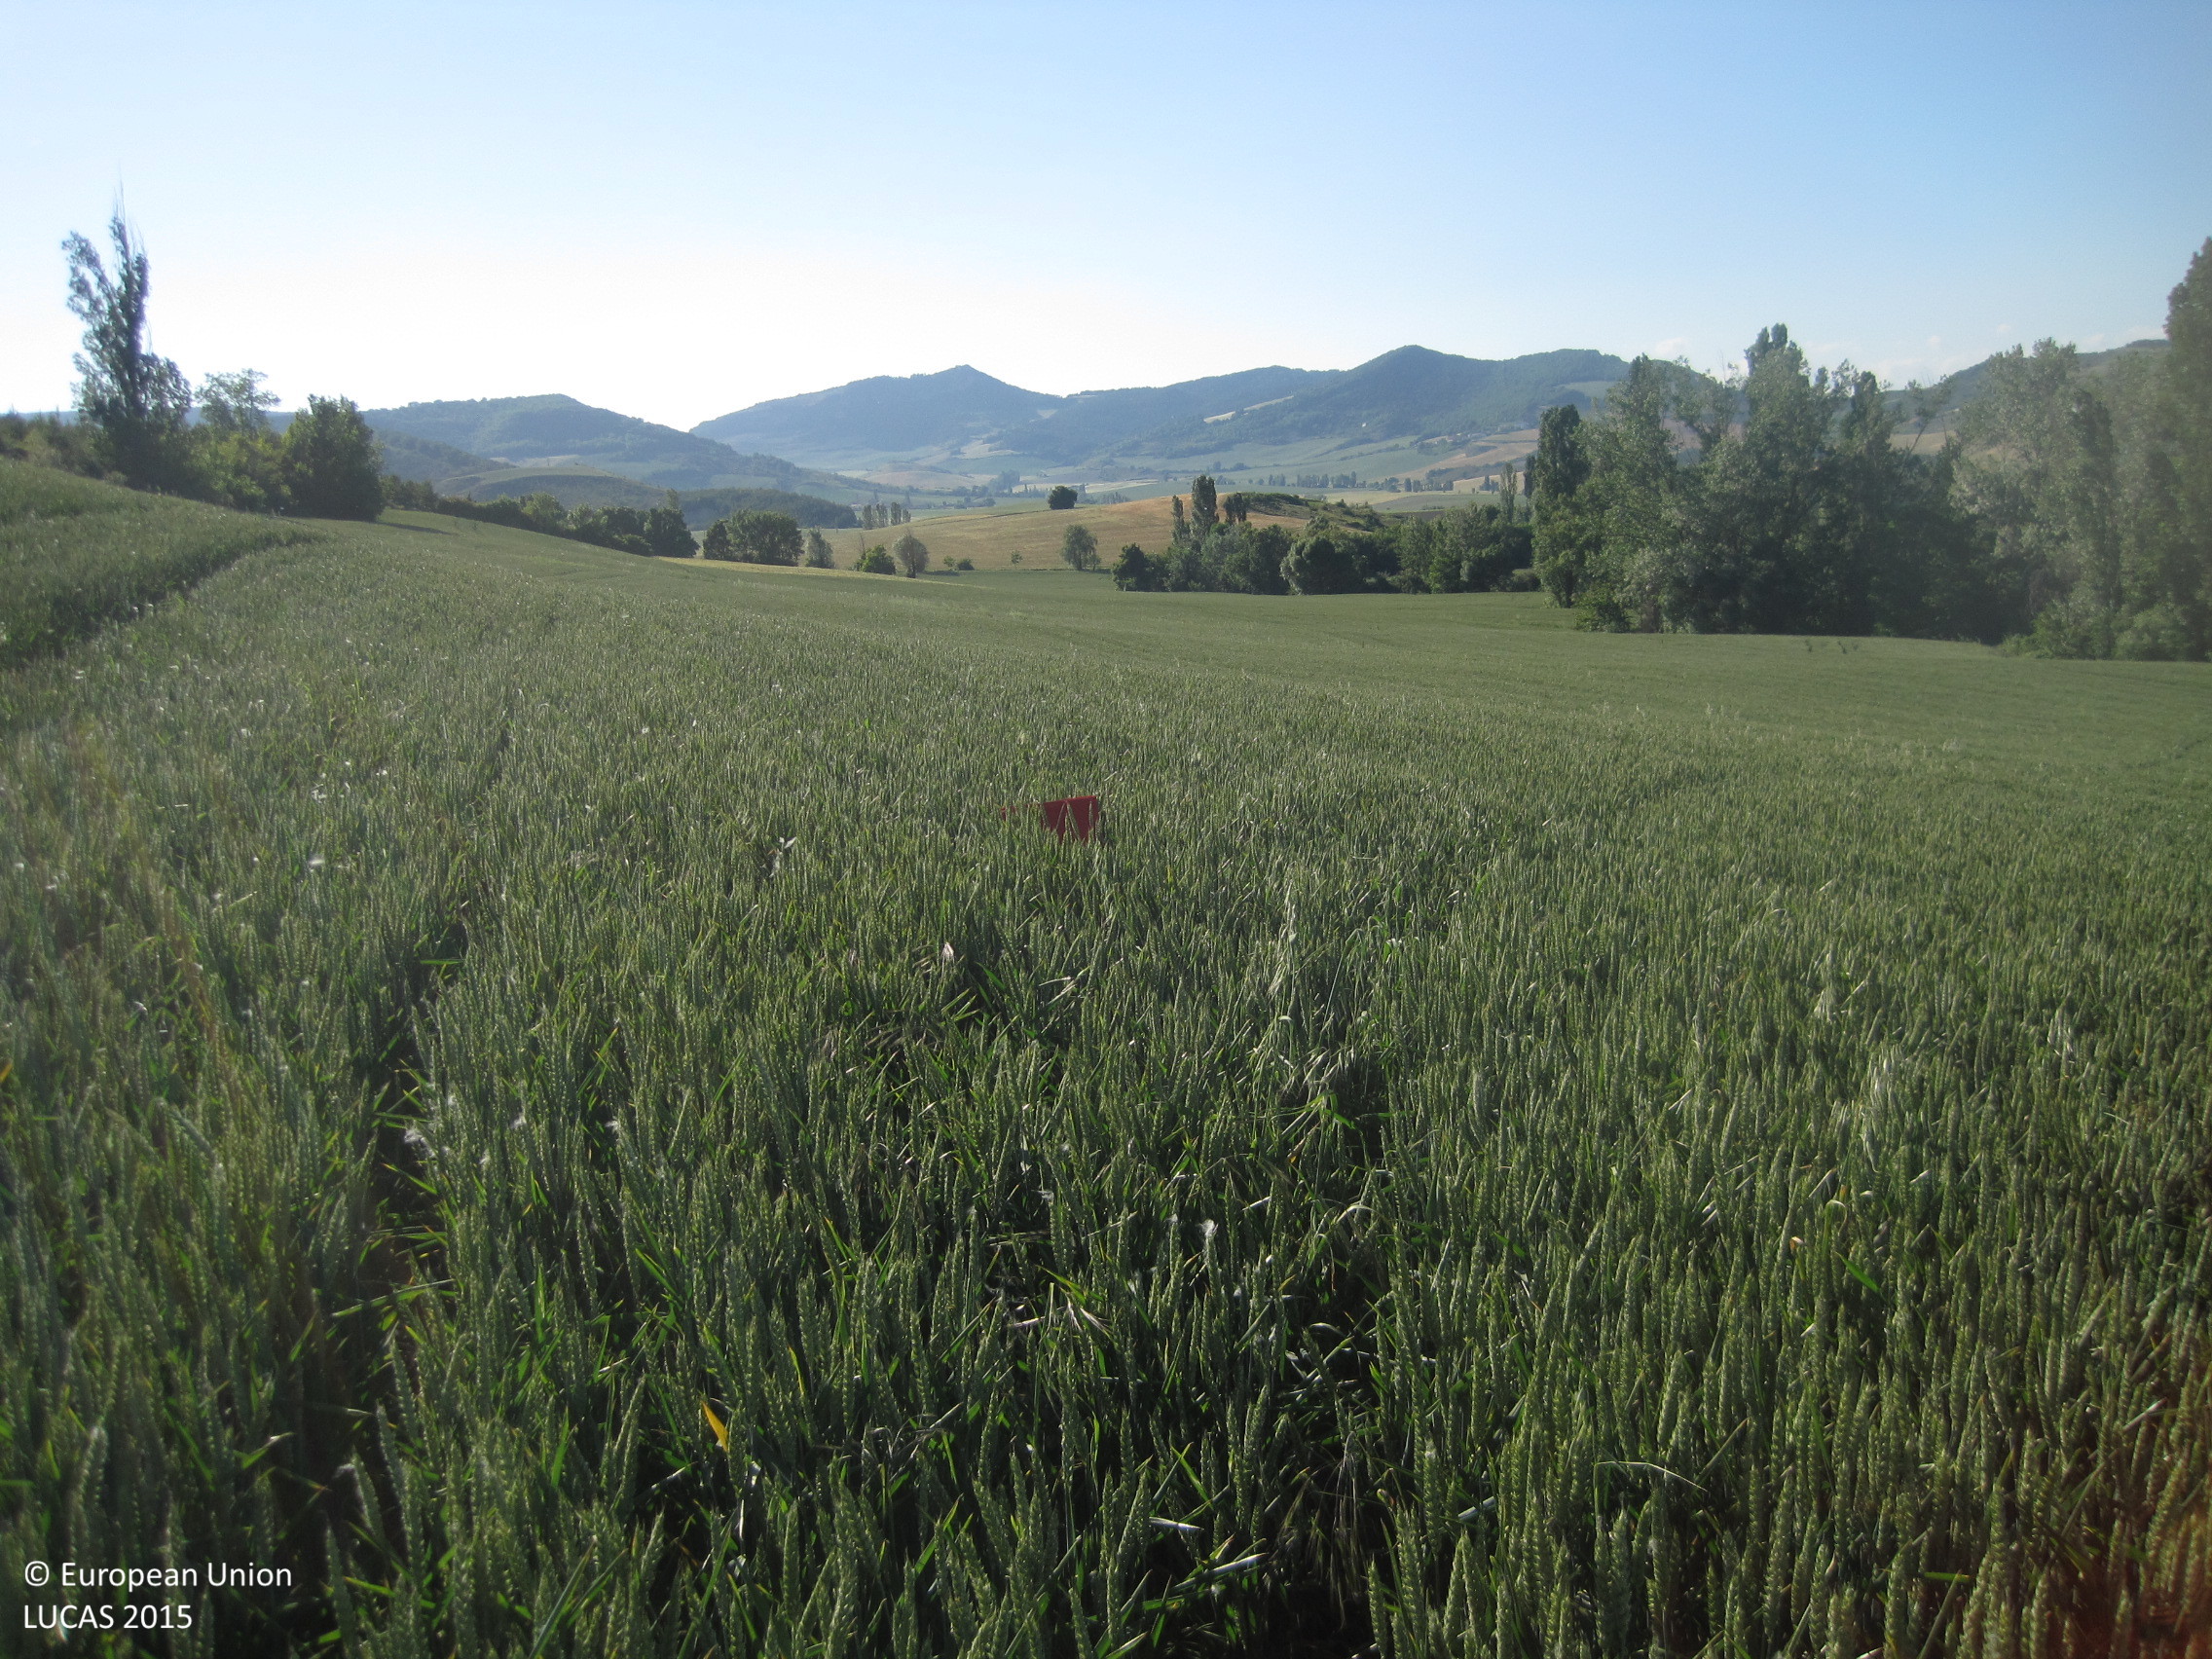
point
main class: Cropland
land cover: Common wheat
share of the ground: > 75 %
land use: Agriculture (excluding fallow land and kitchen gardens)
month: May
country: ES
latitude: 42.7484
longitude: -1.4595
